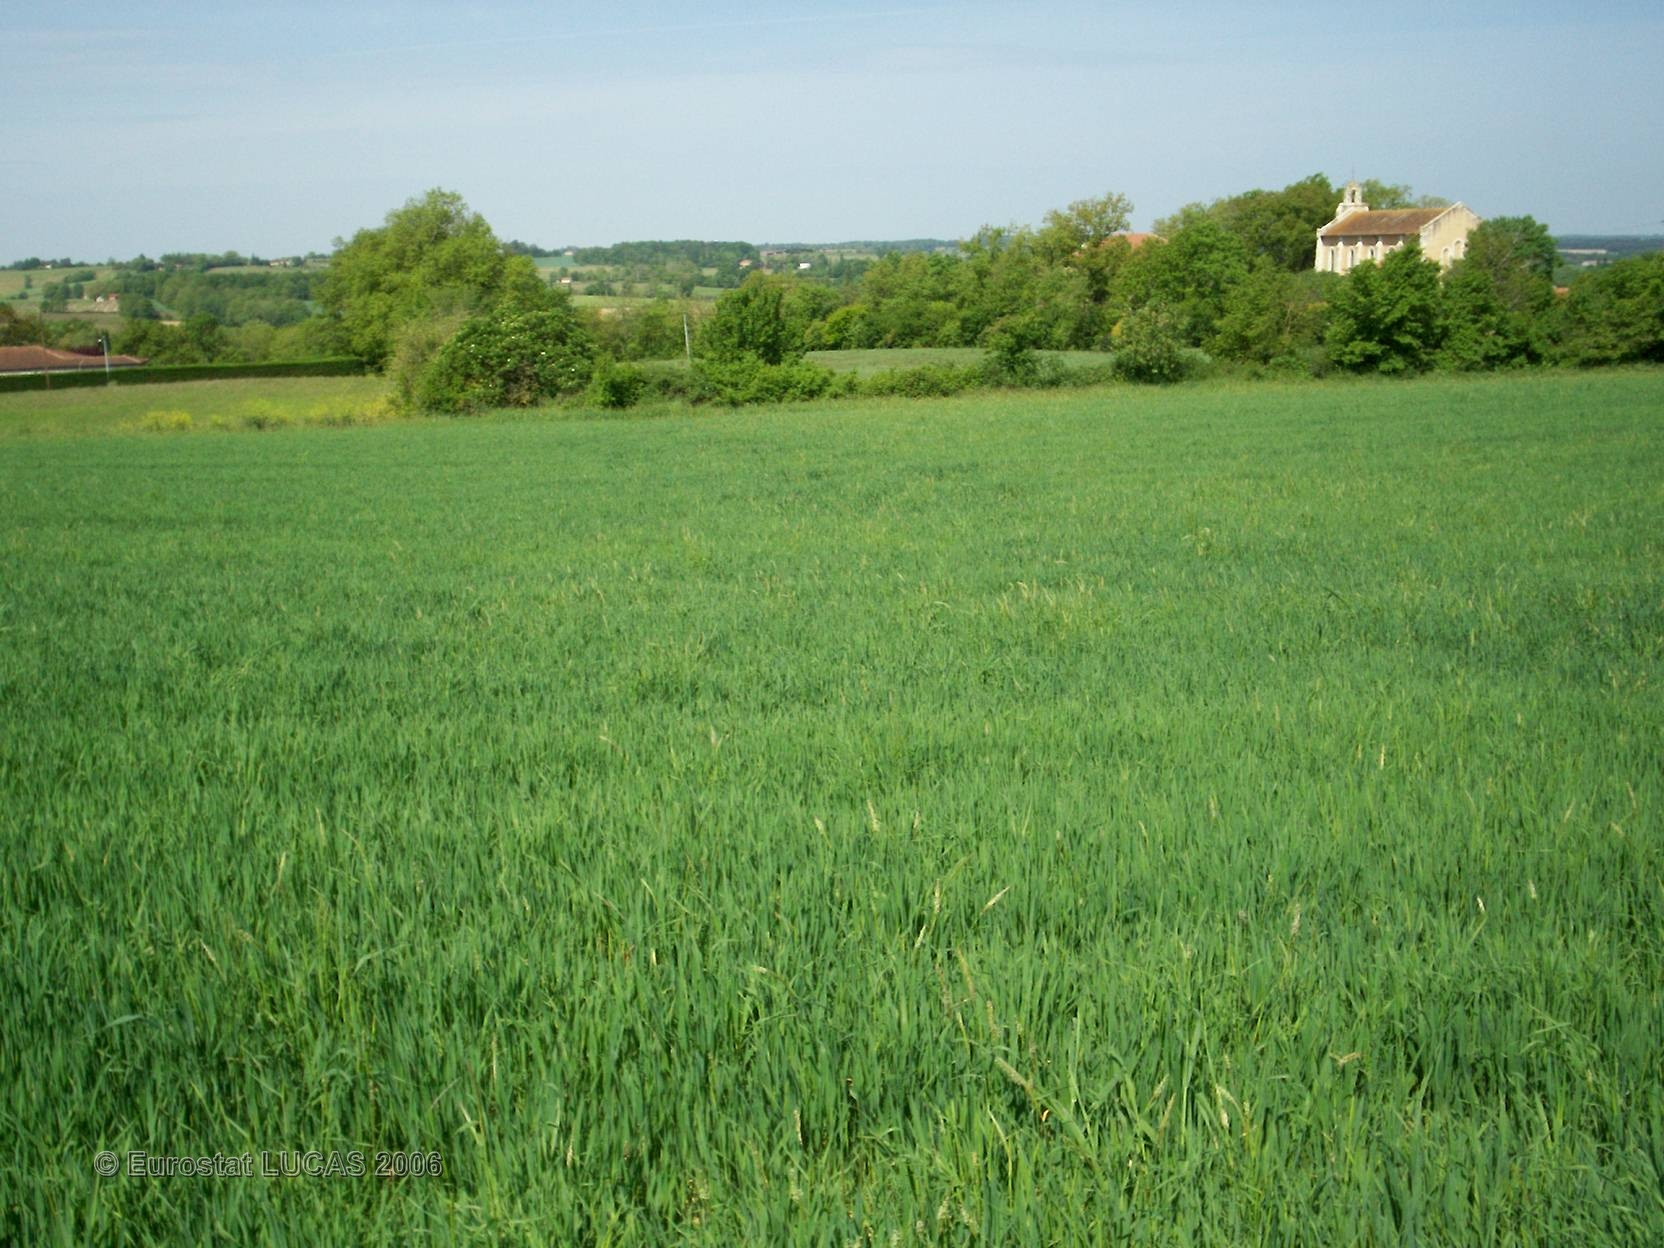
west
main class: Cropland
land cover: Oats
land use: Agriculture (excluding fallow land and kitchen gardens)
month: May
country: FR
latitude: 43.8365
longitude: 0.2564
